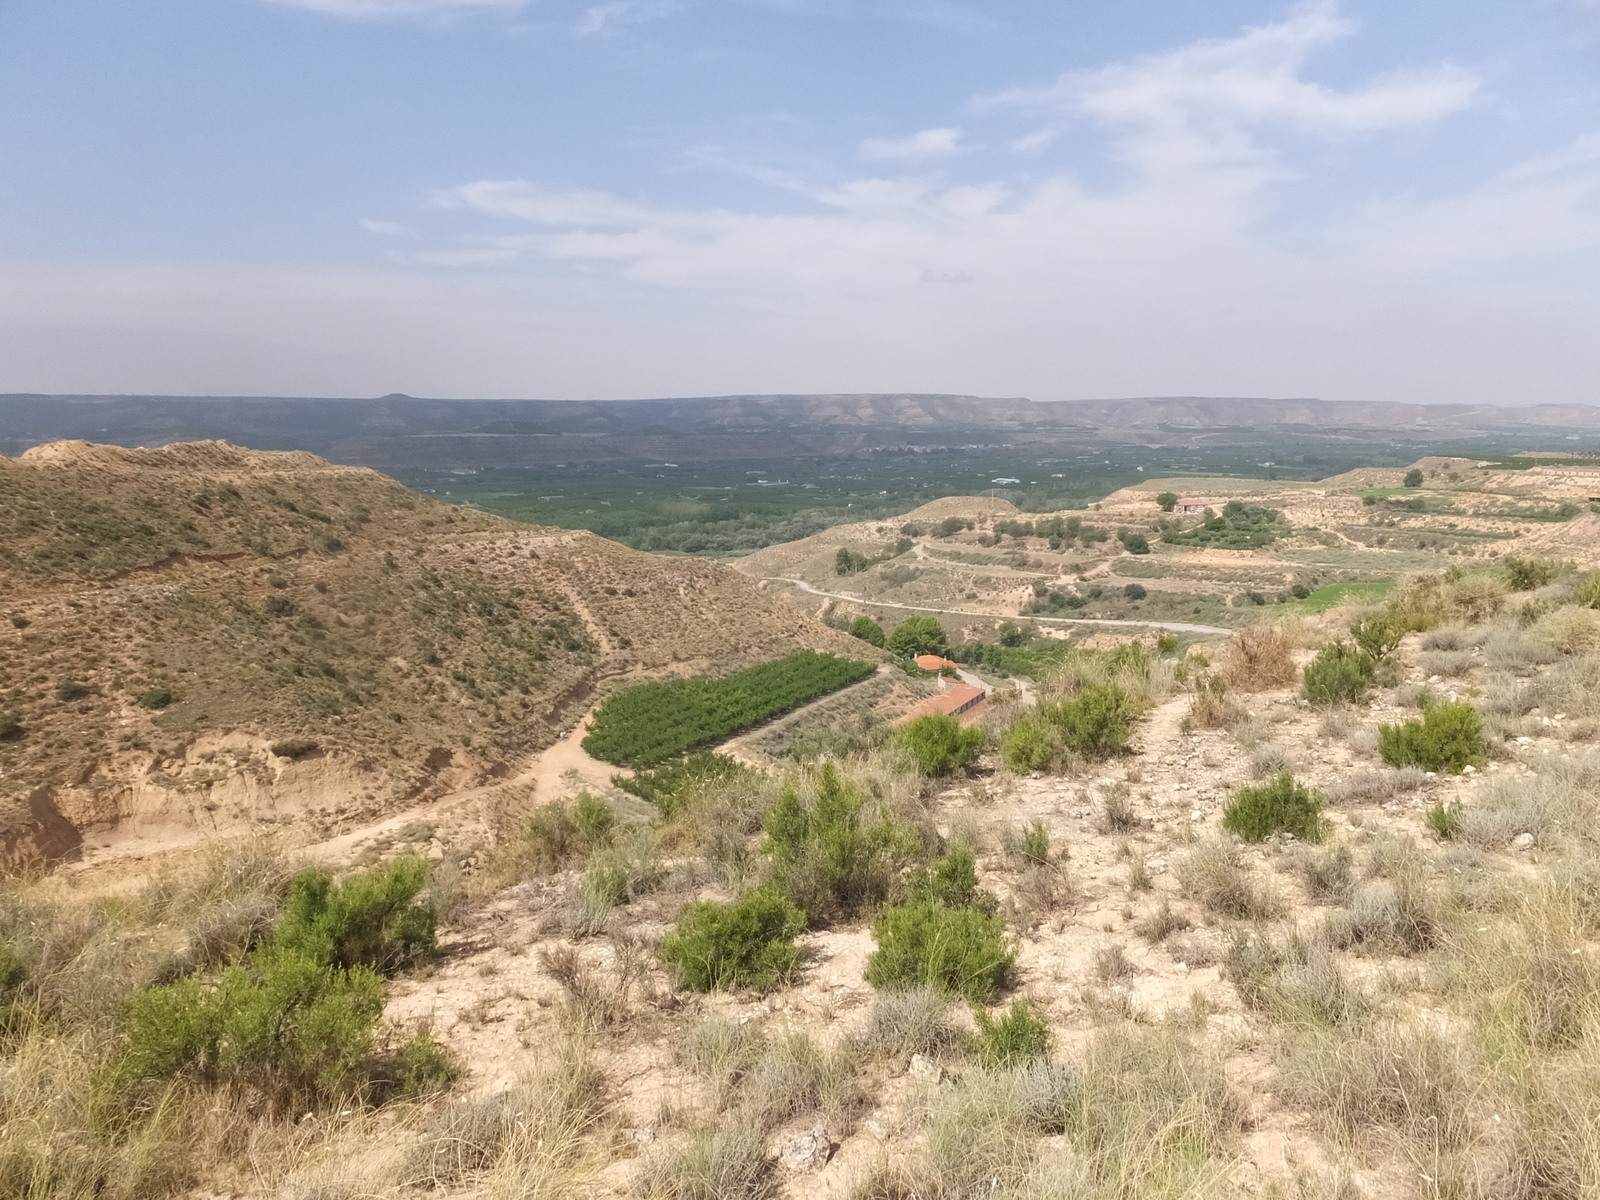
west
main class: Shrubland
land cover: Shrubland without tree cover
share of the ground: > 75 %
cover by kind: shrubs 65 %, consolidated bare surface 20 %, herbaceous plants 15 %
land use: Semi-natural and natural areas not in use
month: August
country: ES
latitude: 41.5545
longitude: 0.3352
